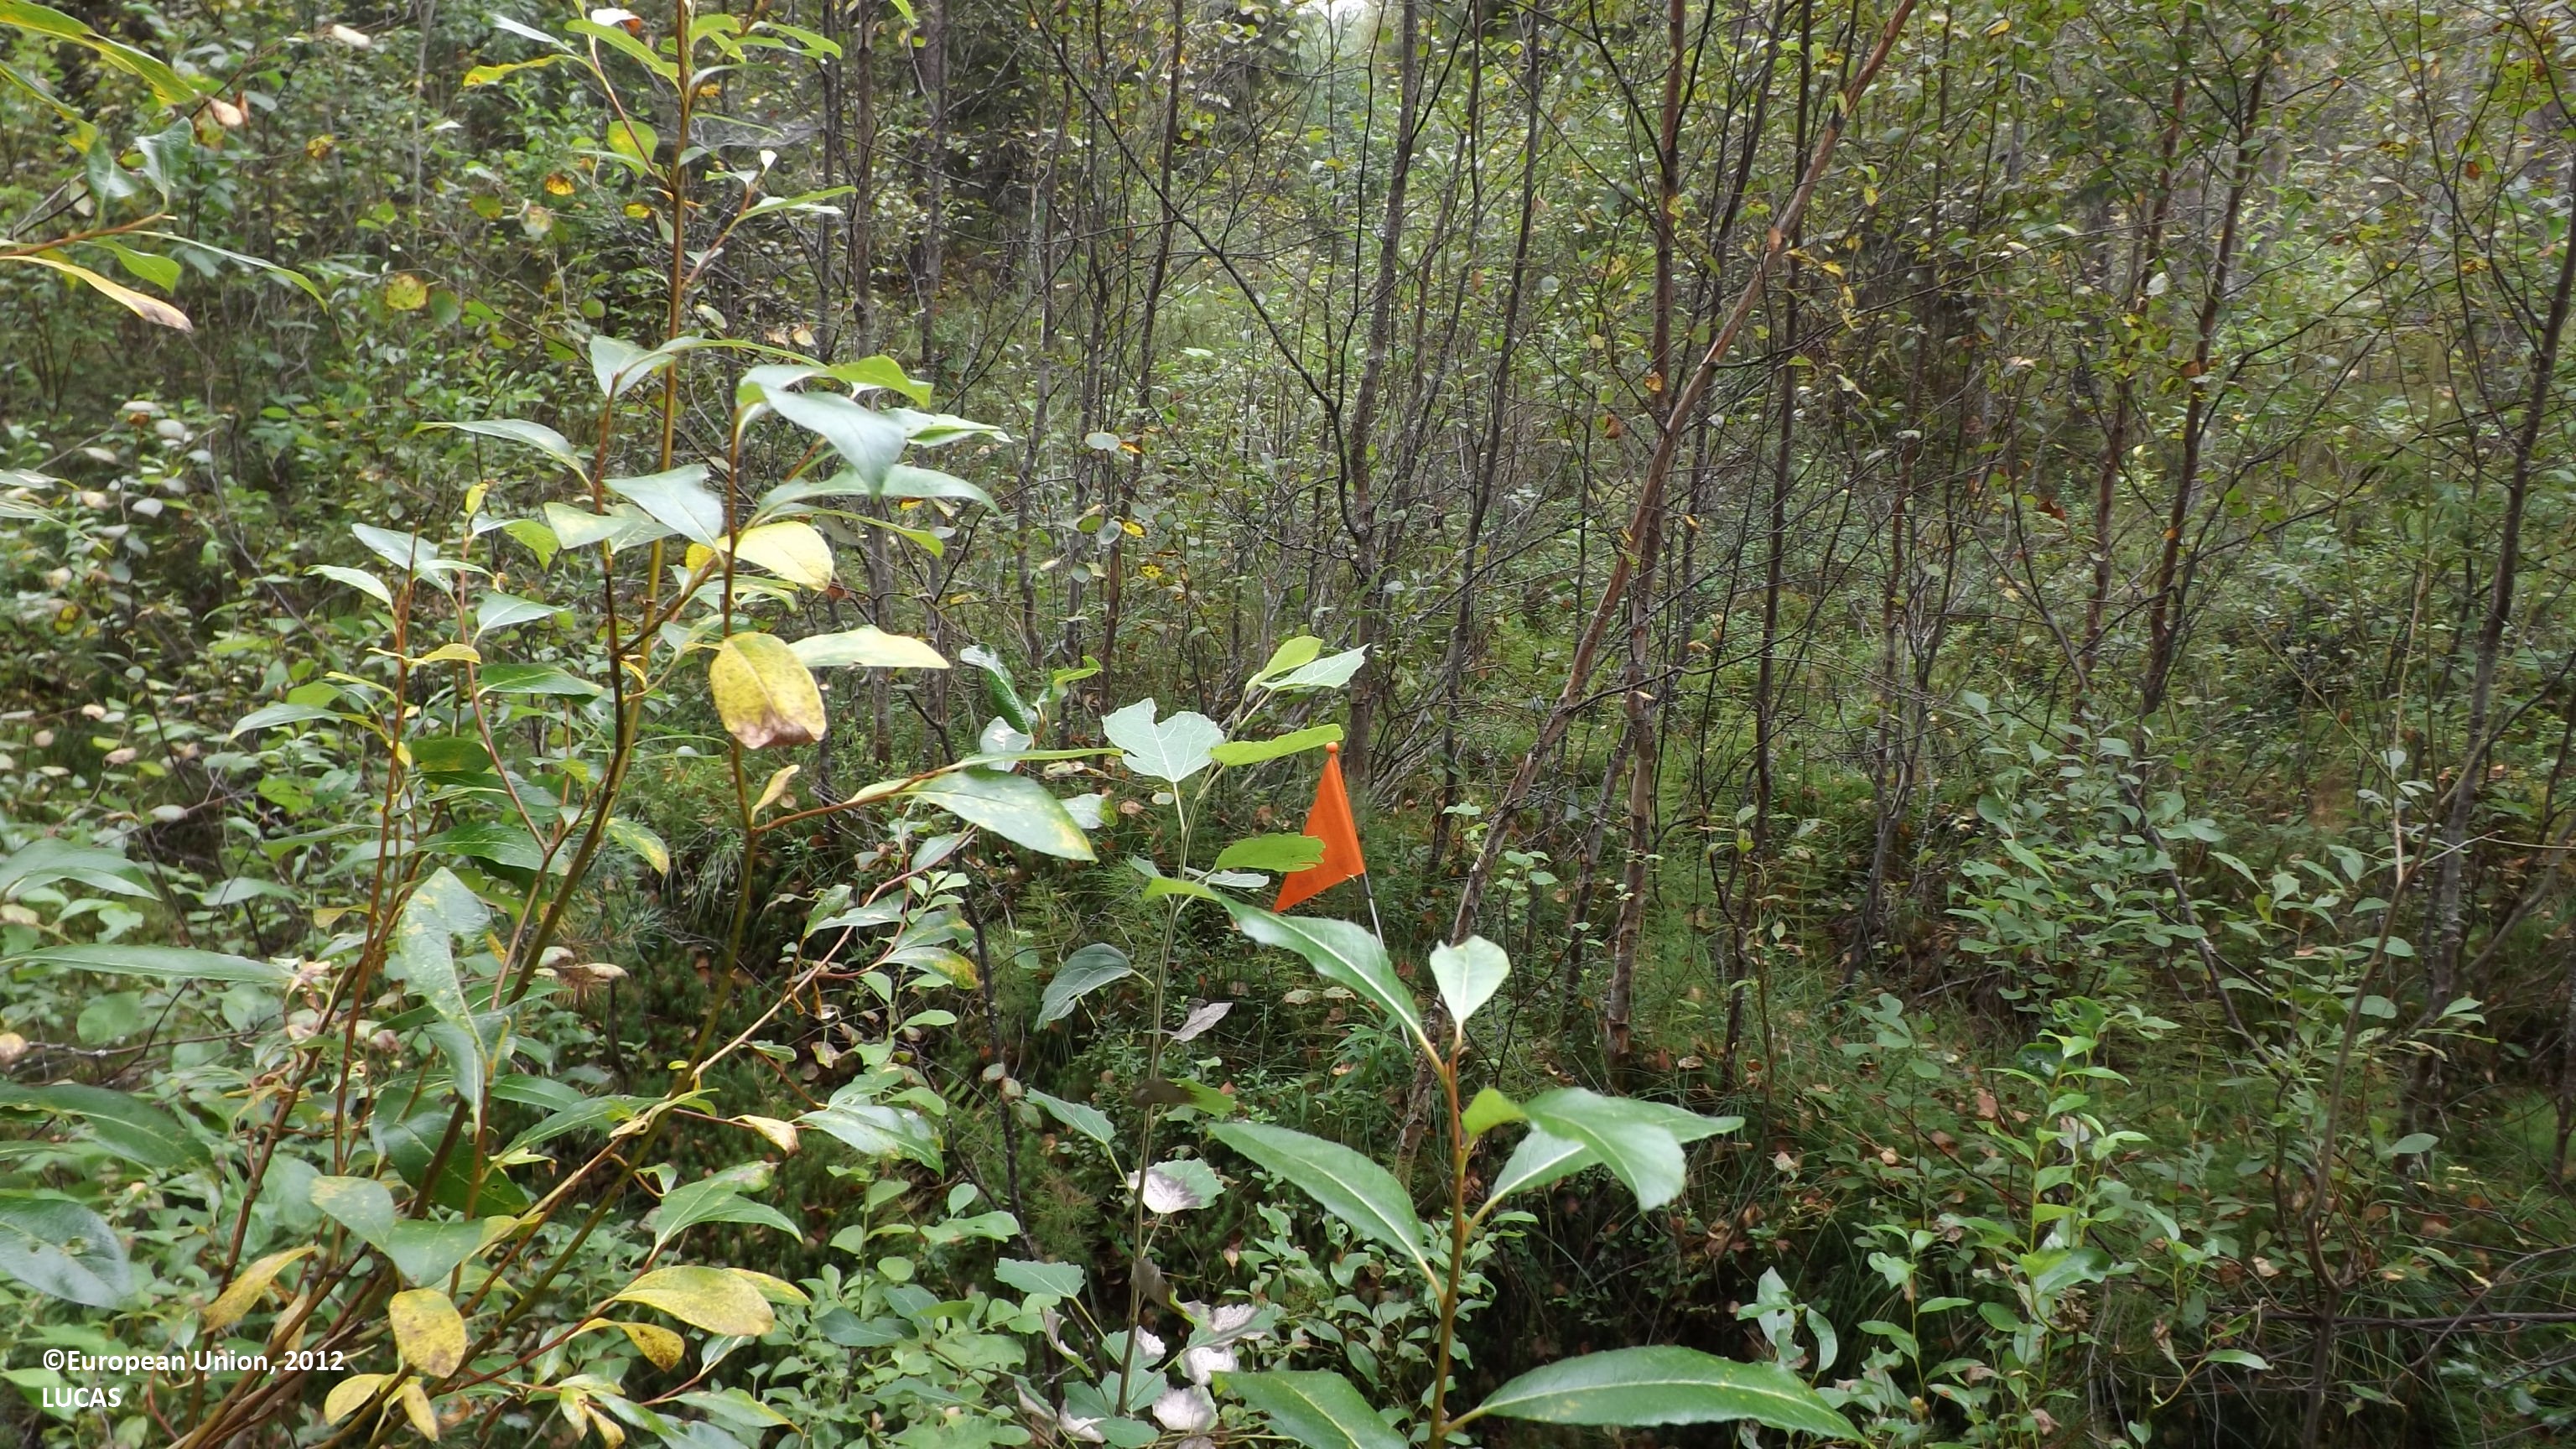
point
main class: Woodland
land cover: Other mixed woodland
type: boreal forest
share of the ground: 50 - 75 %
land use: Forestry
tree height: < 5 m
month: August
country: FI
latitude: 63.8367
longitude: 24.1153
